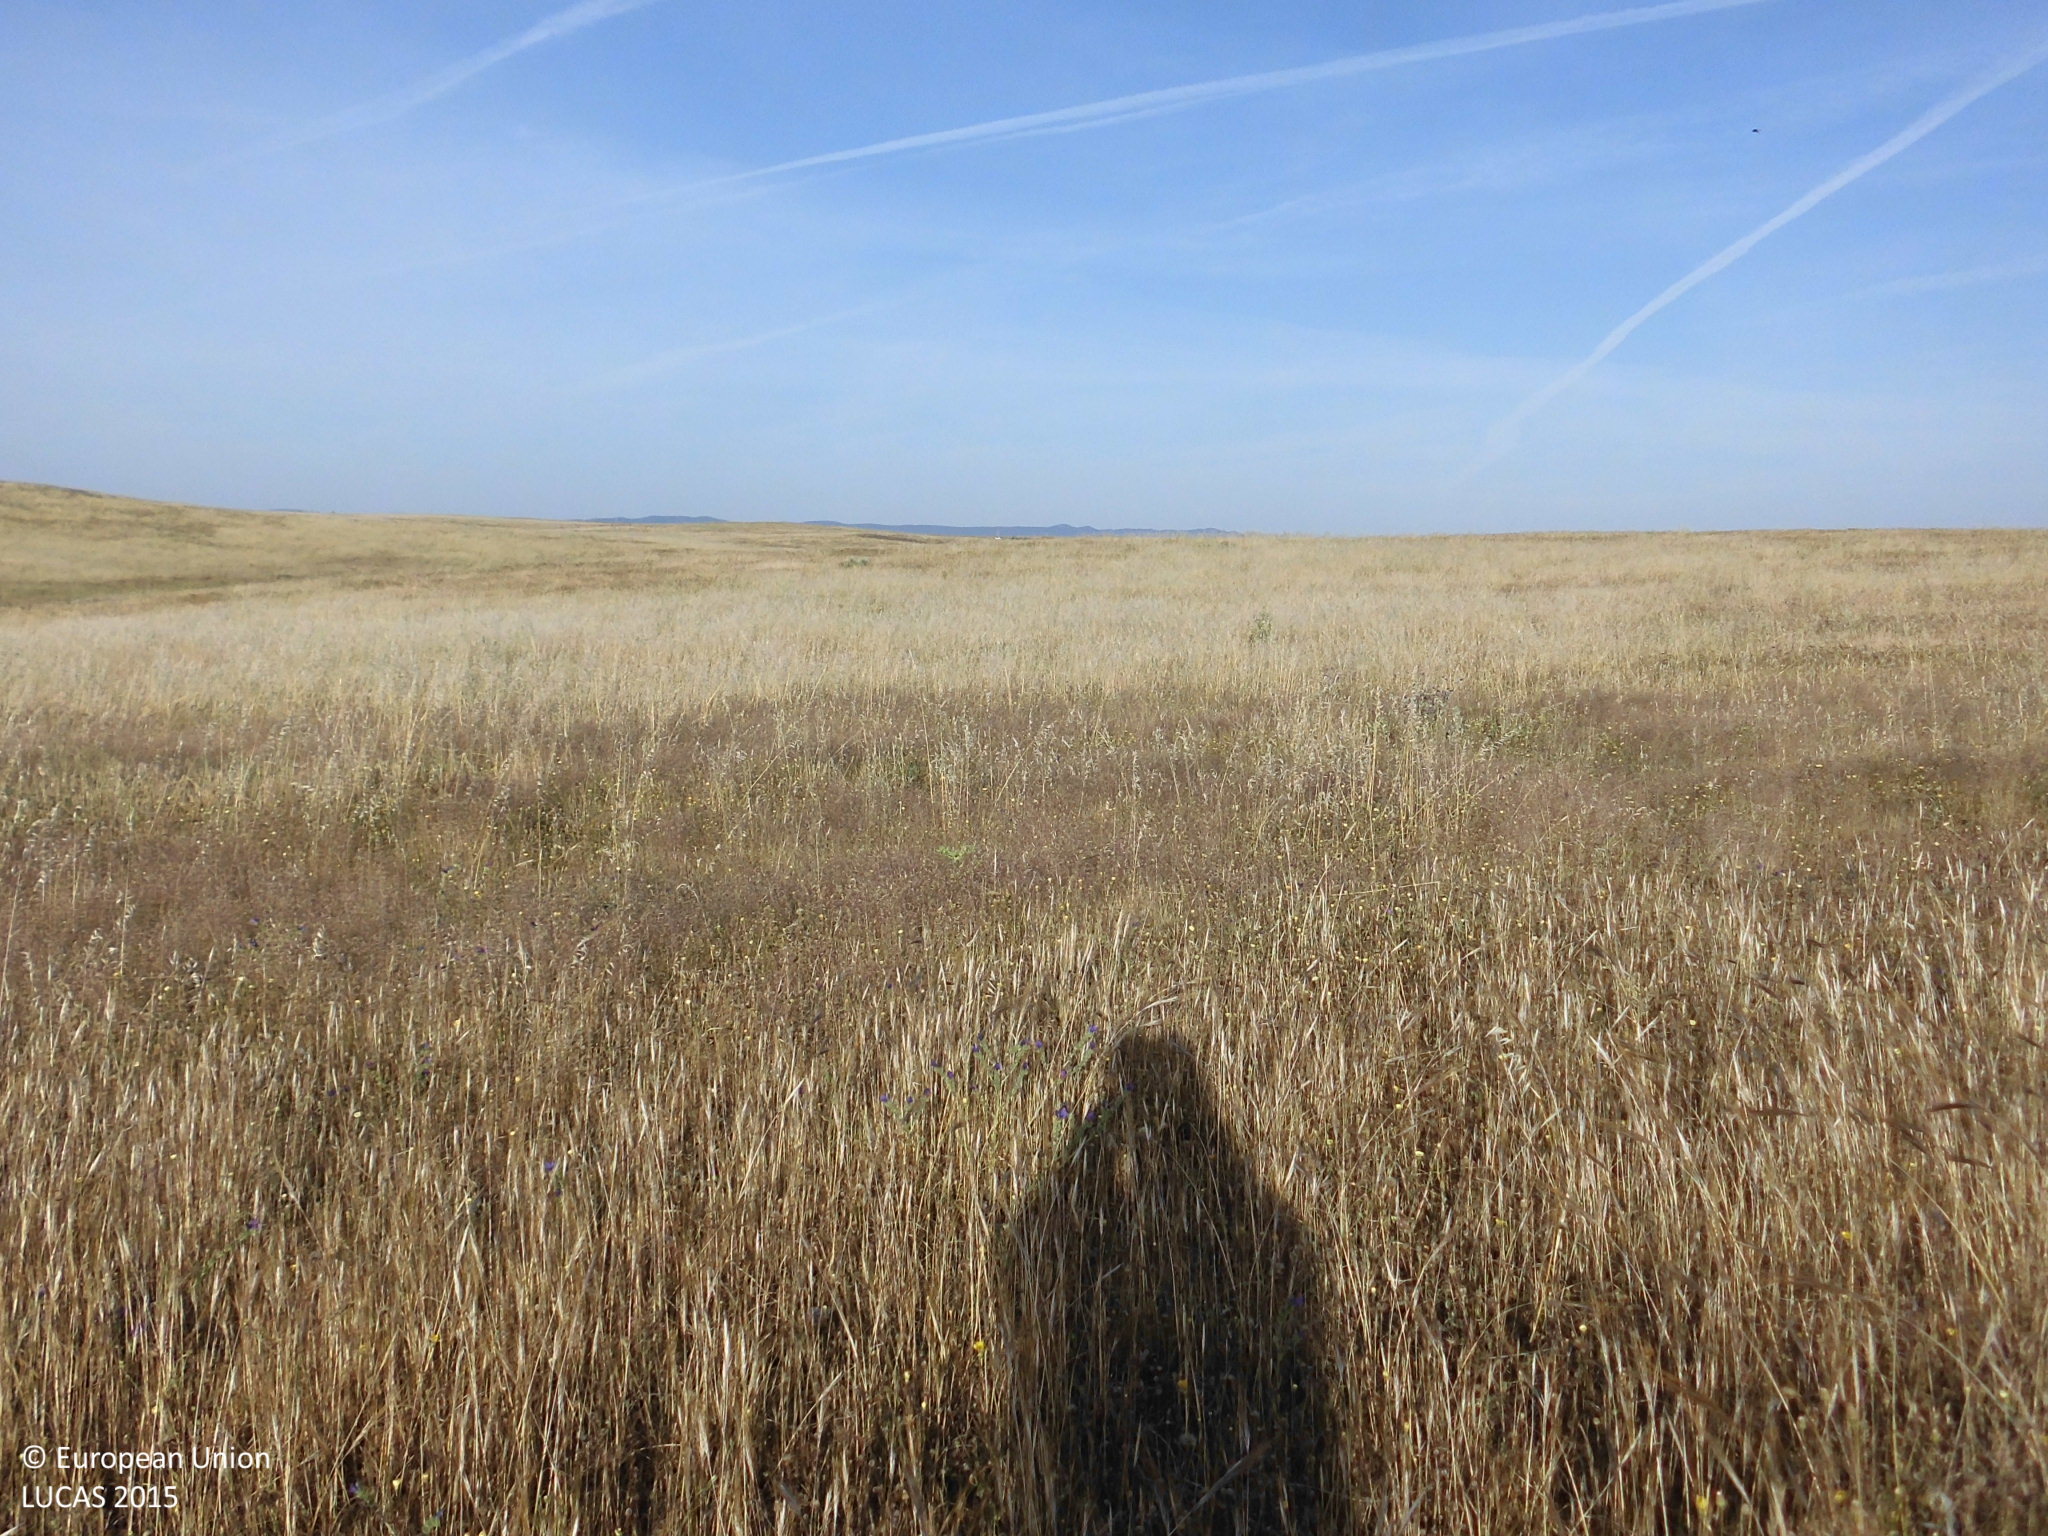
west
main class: Grassland
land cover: Grassland without tree/shrub cover
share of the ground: > 75 %
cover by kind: herbaceous plants 100 %
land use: Agriculture (excluding fallow land and kitchen gardens)
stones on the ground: 10 - 25 %
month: May
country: ES
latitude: 39.6301
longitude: -6.9413
